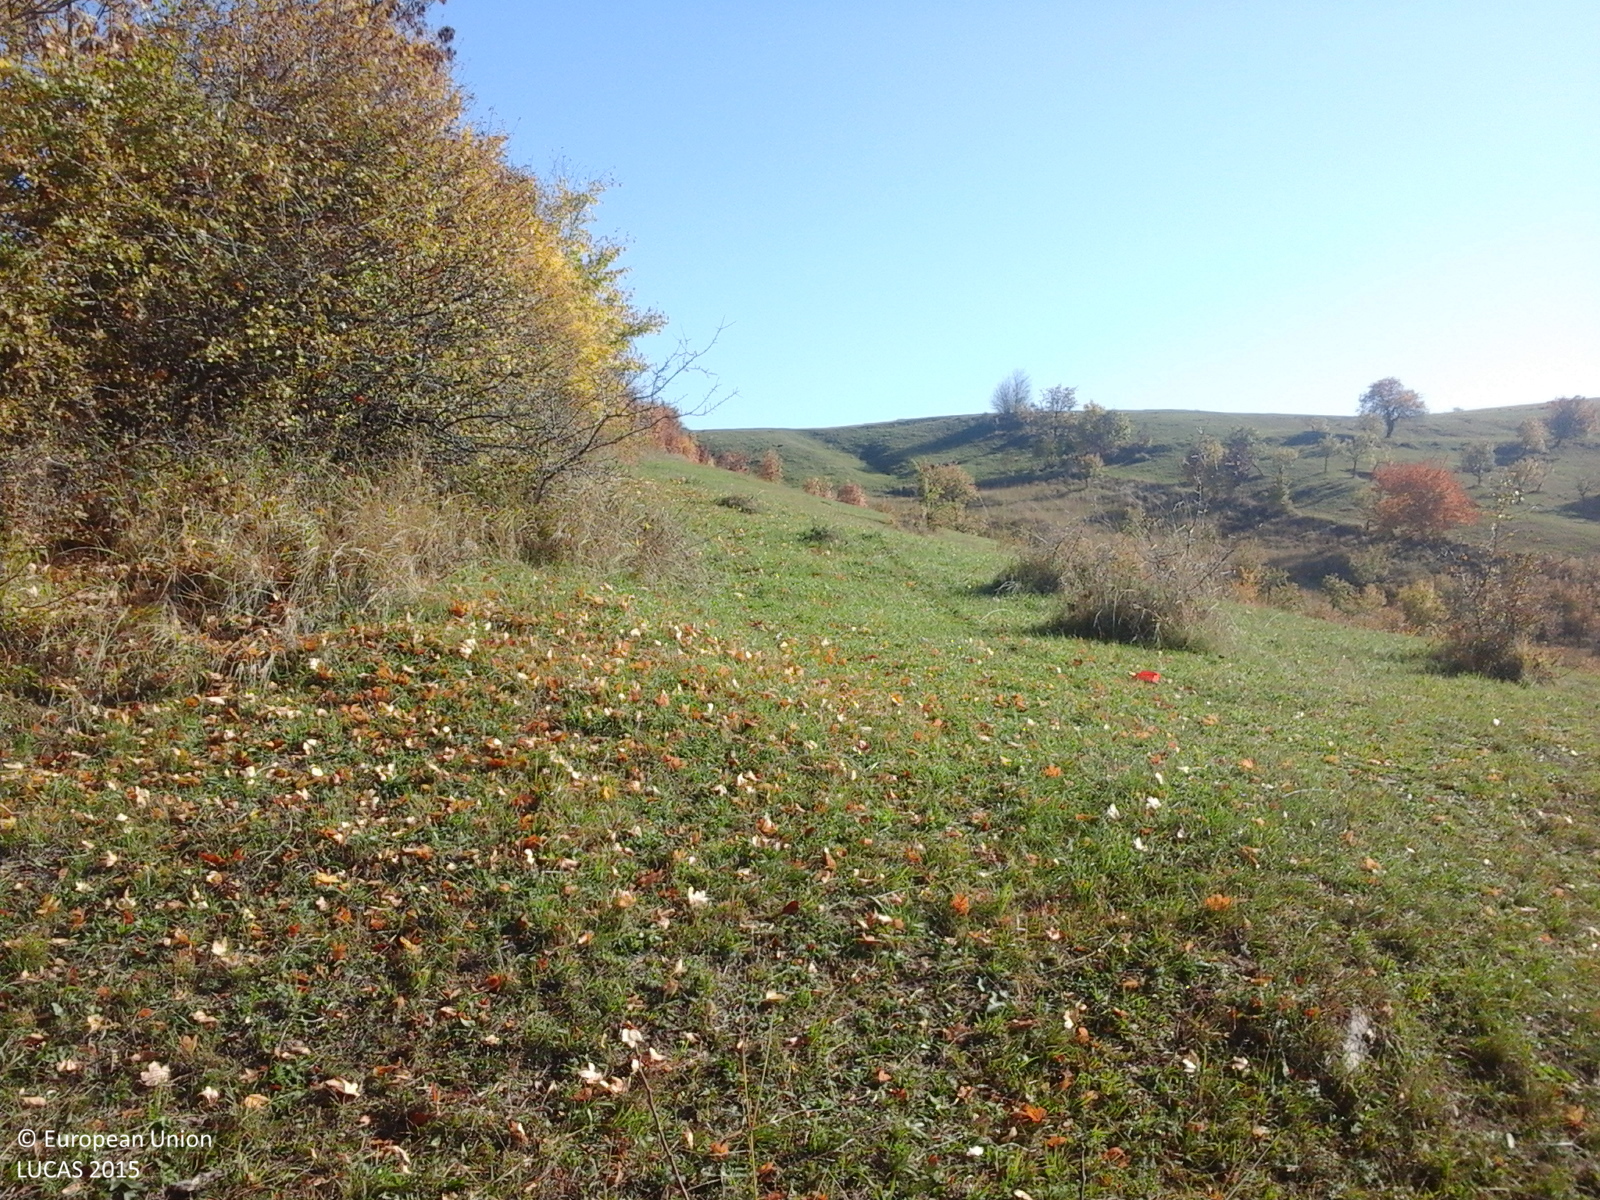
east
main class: Shrubland
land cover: Shrubland without tree cover
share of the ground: > 75 %
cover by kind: shrubs 100 %
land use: Fallow land
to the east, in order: Shrubland without tree cover; Grassland without tree/shrub cover; Grassland with sparse tree/shrub cover; Grassland without tree/shrub cover
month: October
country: RO
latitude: 45.3268
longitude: 26.5454
